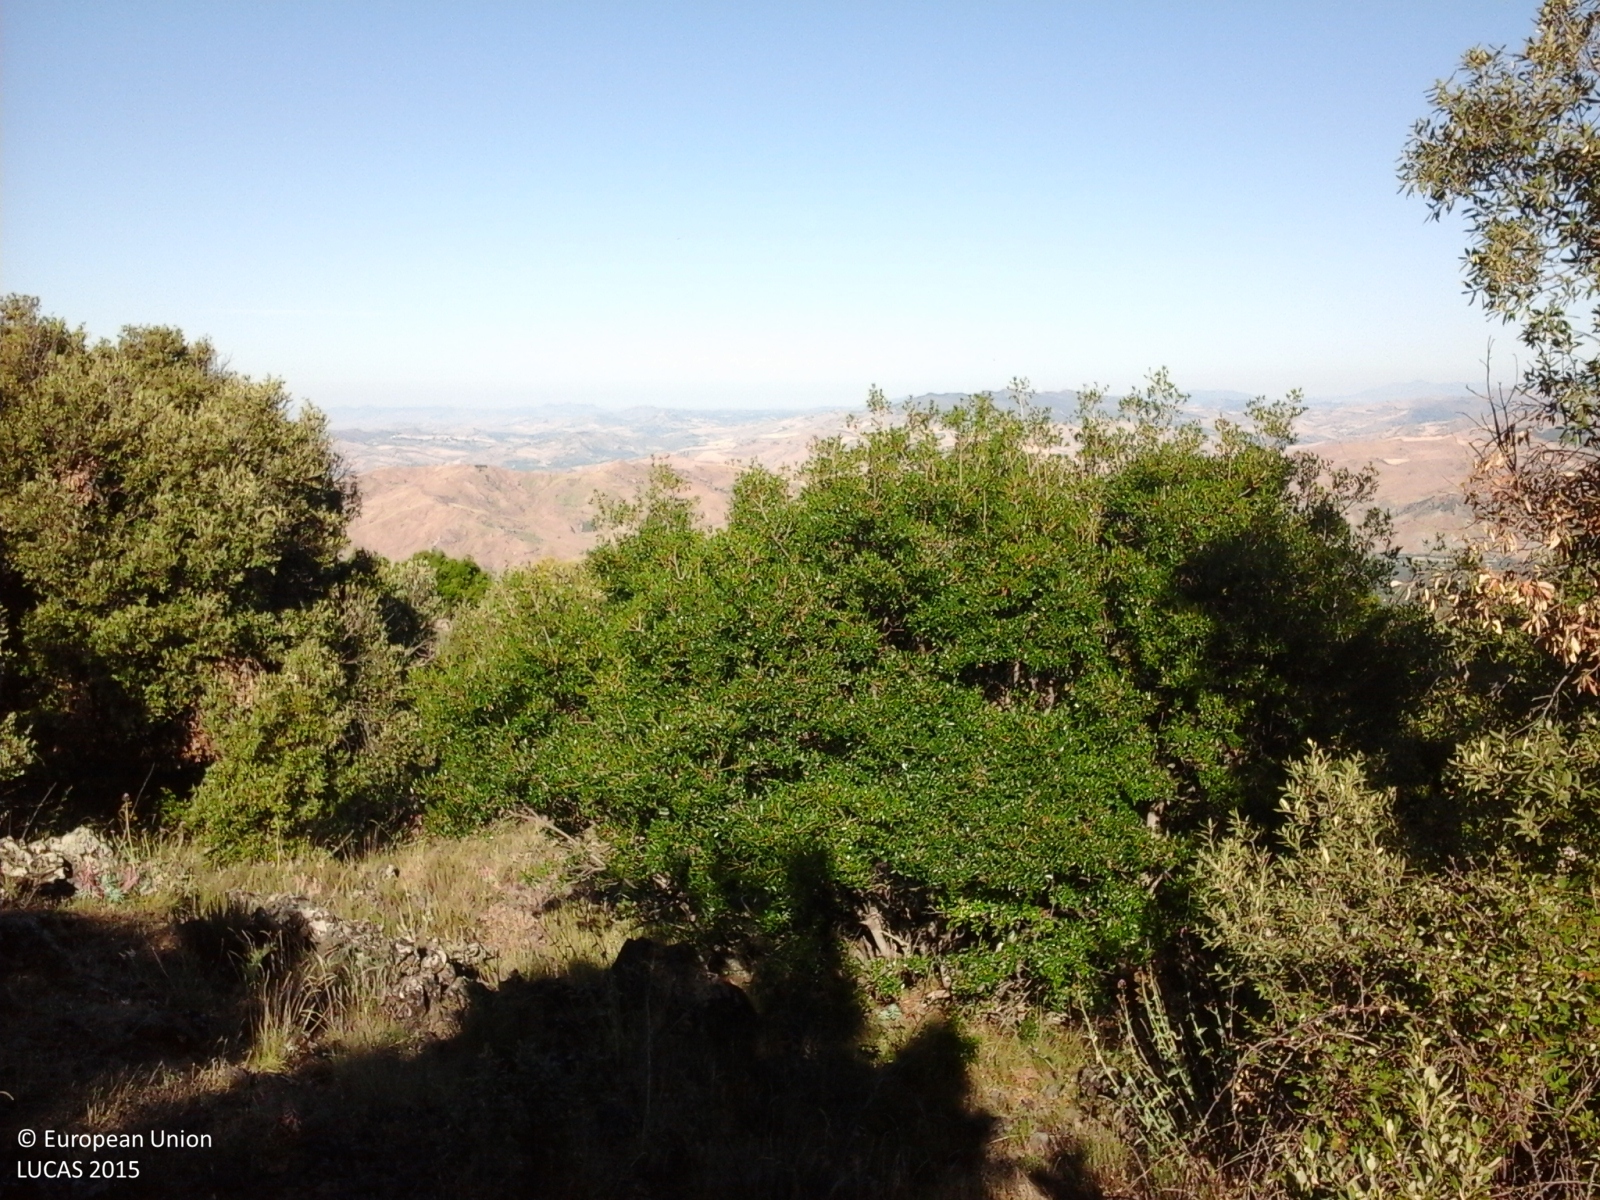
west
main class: Woodland
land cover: Broadleaved woodland
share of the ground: > 75 %
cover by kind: broadleaved forest trees 60 %, shrubs 20 %, coniferous forest trees 10 %, herbaceous plants 5 %, unconsolidated bare surface 5 %
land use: Amenities, museums, leisure
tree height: < 5 m
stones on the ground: > 50 %
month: June
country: IT
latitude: 37.7325
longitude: 14.8565
